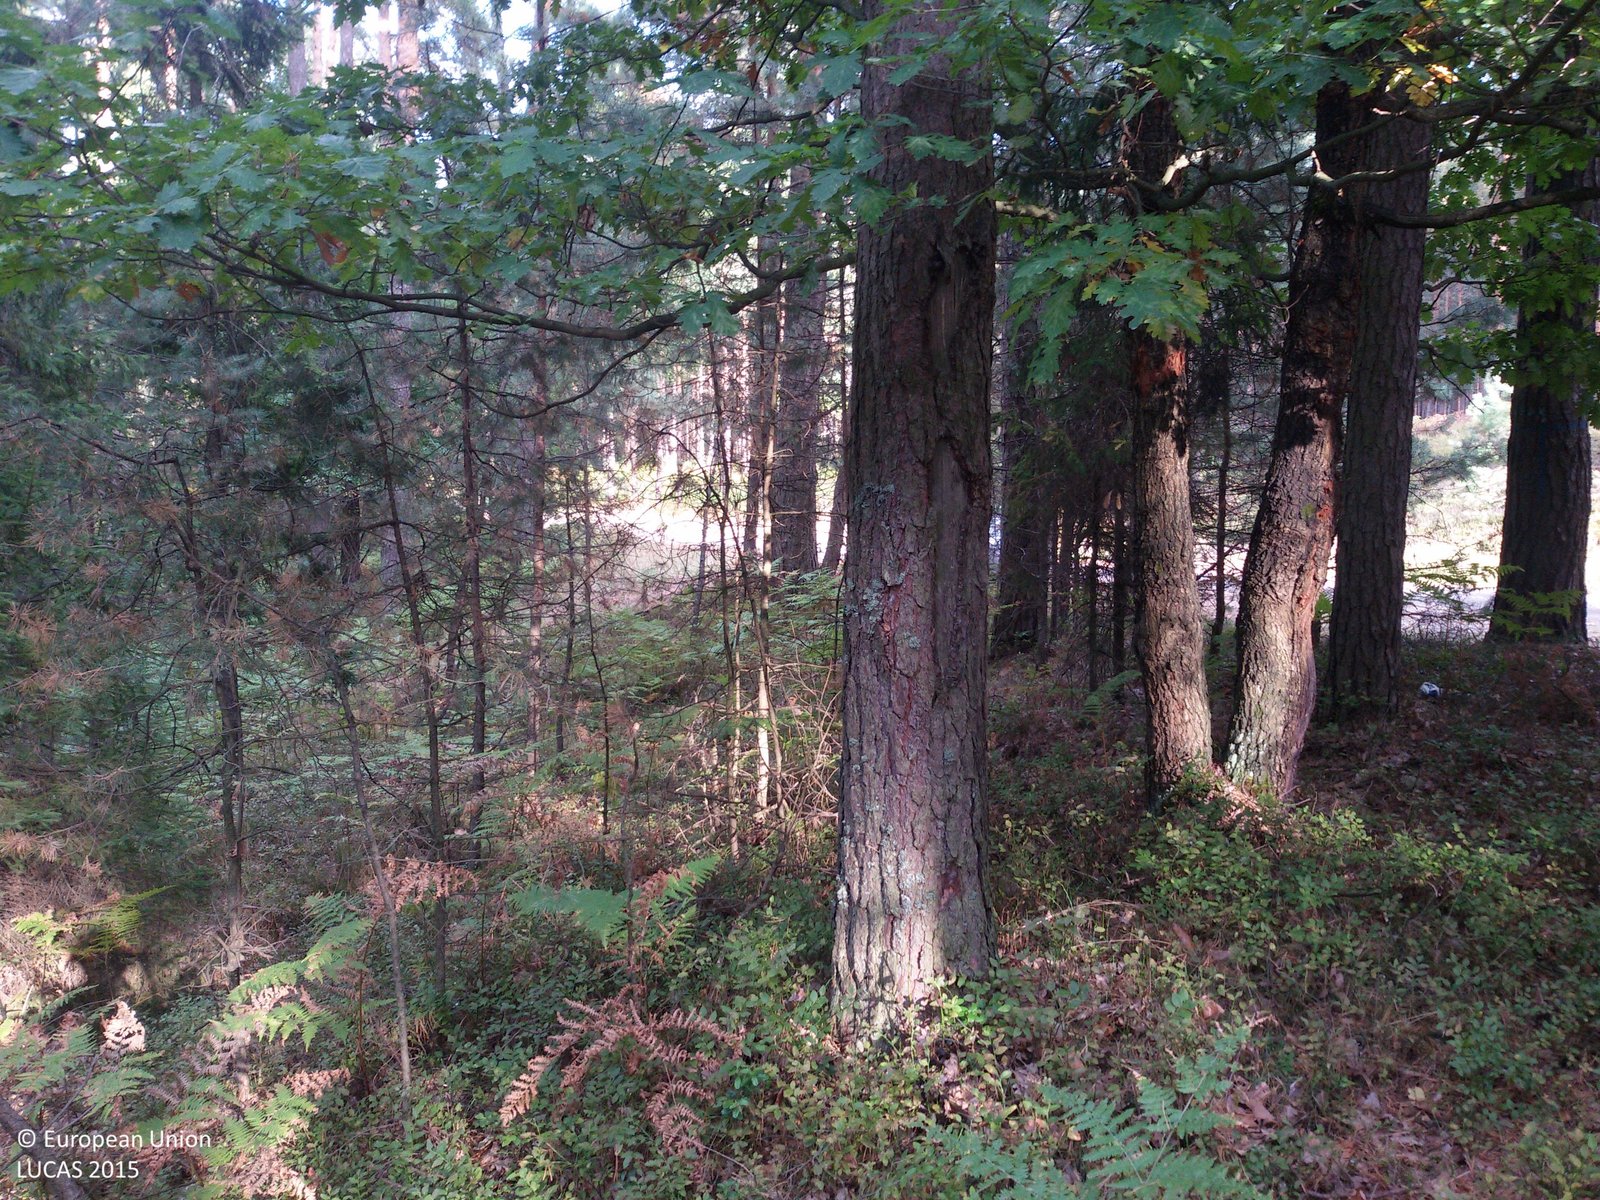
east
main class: Woodland
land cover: Pine dominated coniferous woodland
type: hemiboreal forest and nemoral coniferous forest and mixed broadleaved-coniferous forest
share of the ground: > 75 %
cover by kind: coniferous forest trees 75 %, herbaceous plants 15 %, lichens and mosses 10 %
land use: Forestry
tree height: > 5 m
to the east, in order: Pine dominated coniferous woodland; Paved roads, cycling and walking lanes; Pine dominated coniferous woodland; Spontaneously vegetated surfaces; Pine dominated coniferous woodland; Tracks; Pine dominated coniferous woodland
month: September
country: PL
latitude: 50.7705
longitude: 18.7417
